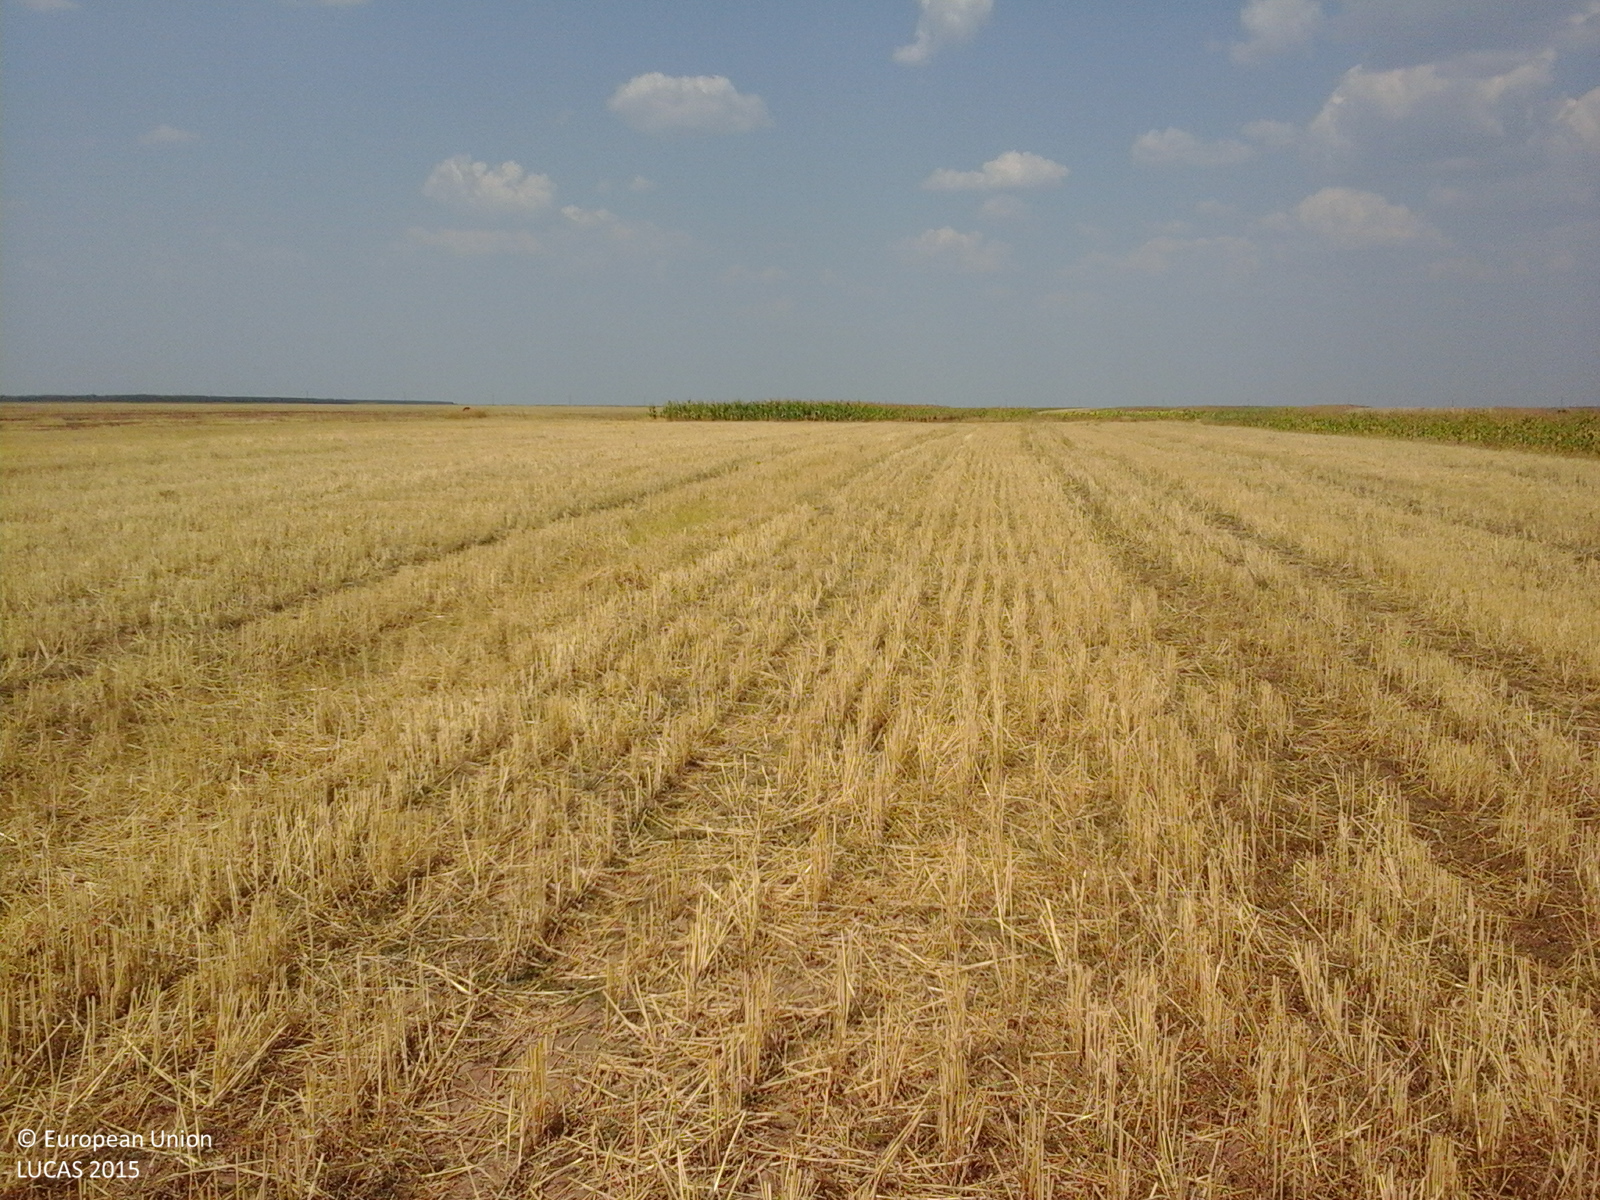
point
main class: Cropland
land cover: Durum wheat
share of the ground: > 75 %
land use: Agriculture (excluding fallow land and kitchen gardens)
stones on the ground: < 10 %
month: August
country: RO
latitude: 44.3903
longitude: 23.1145
